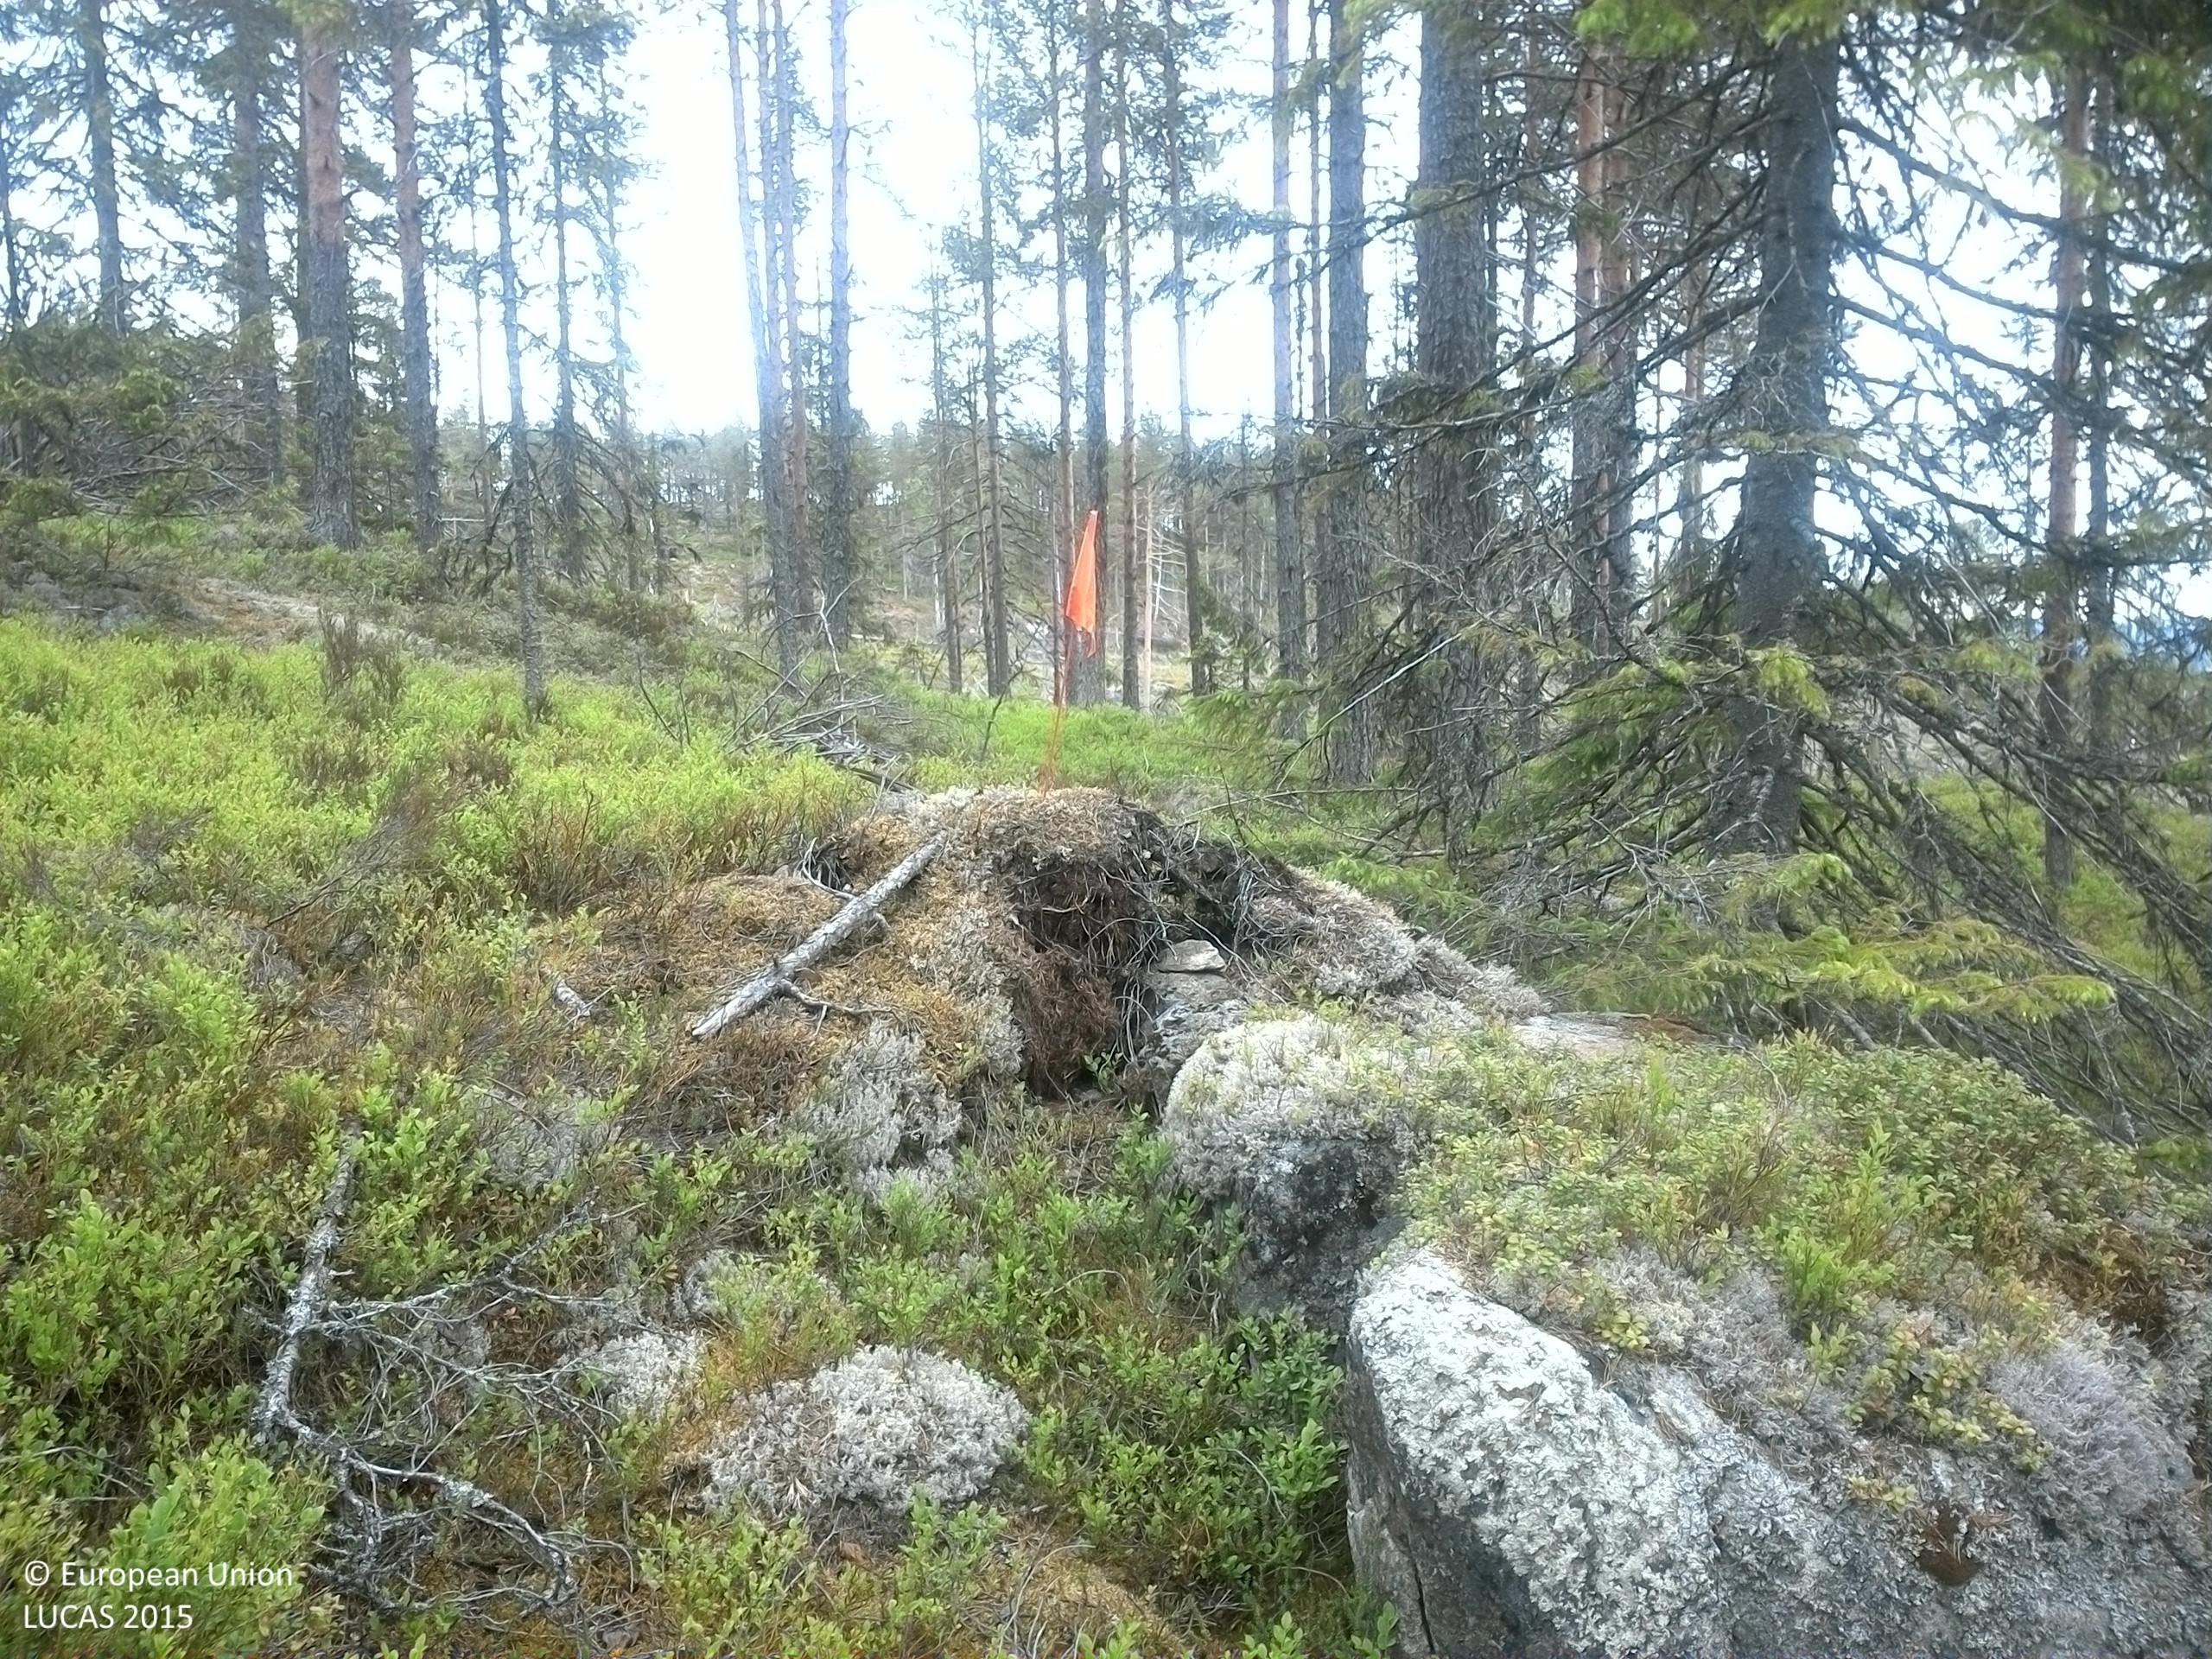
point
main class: Woodland
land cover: Pine dominated coniferous woodland
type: boreal forest
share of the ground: 25 - 50 %
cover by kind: shrubs 55 %, coniferous forest trees 35 %, lichens and mosses 10 %
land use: Forestry
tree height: > 5 m
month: June
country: SE
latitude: 63.4770
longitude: 17.8628
